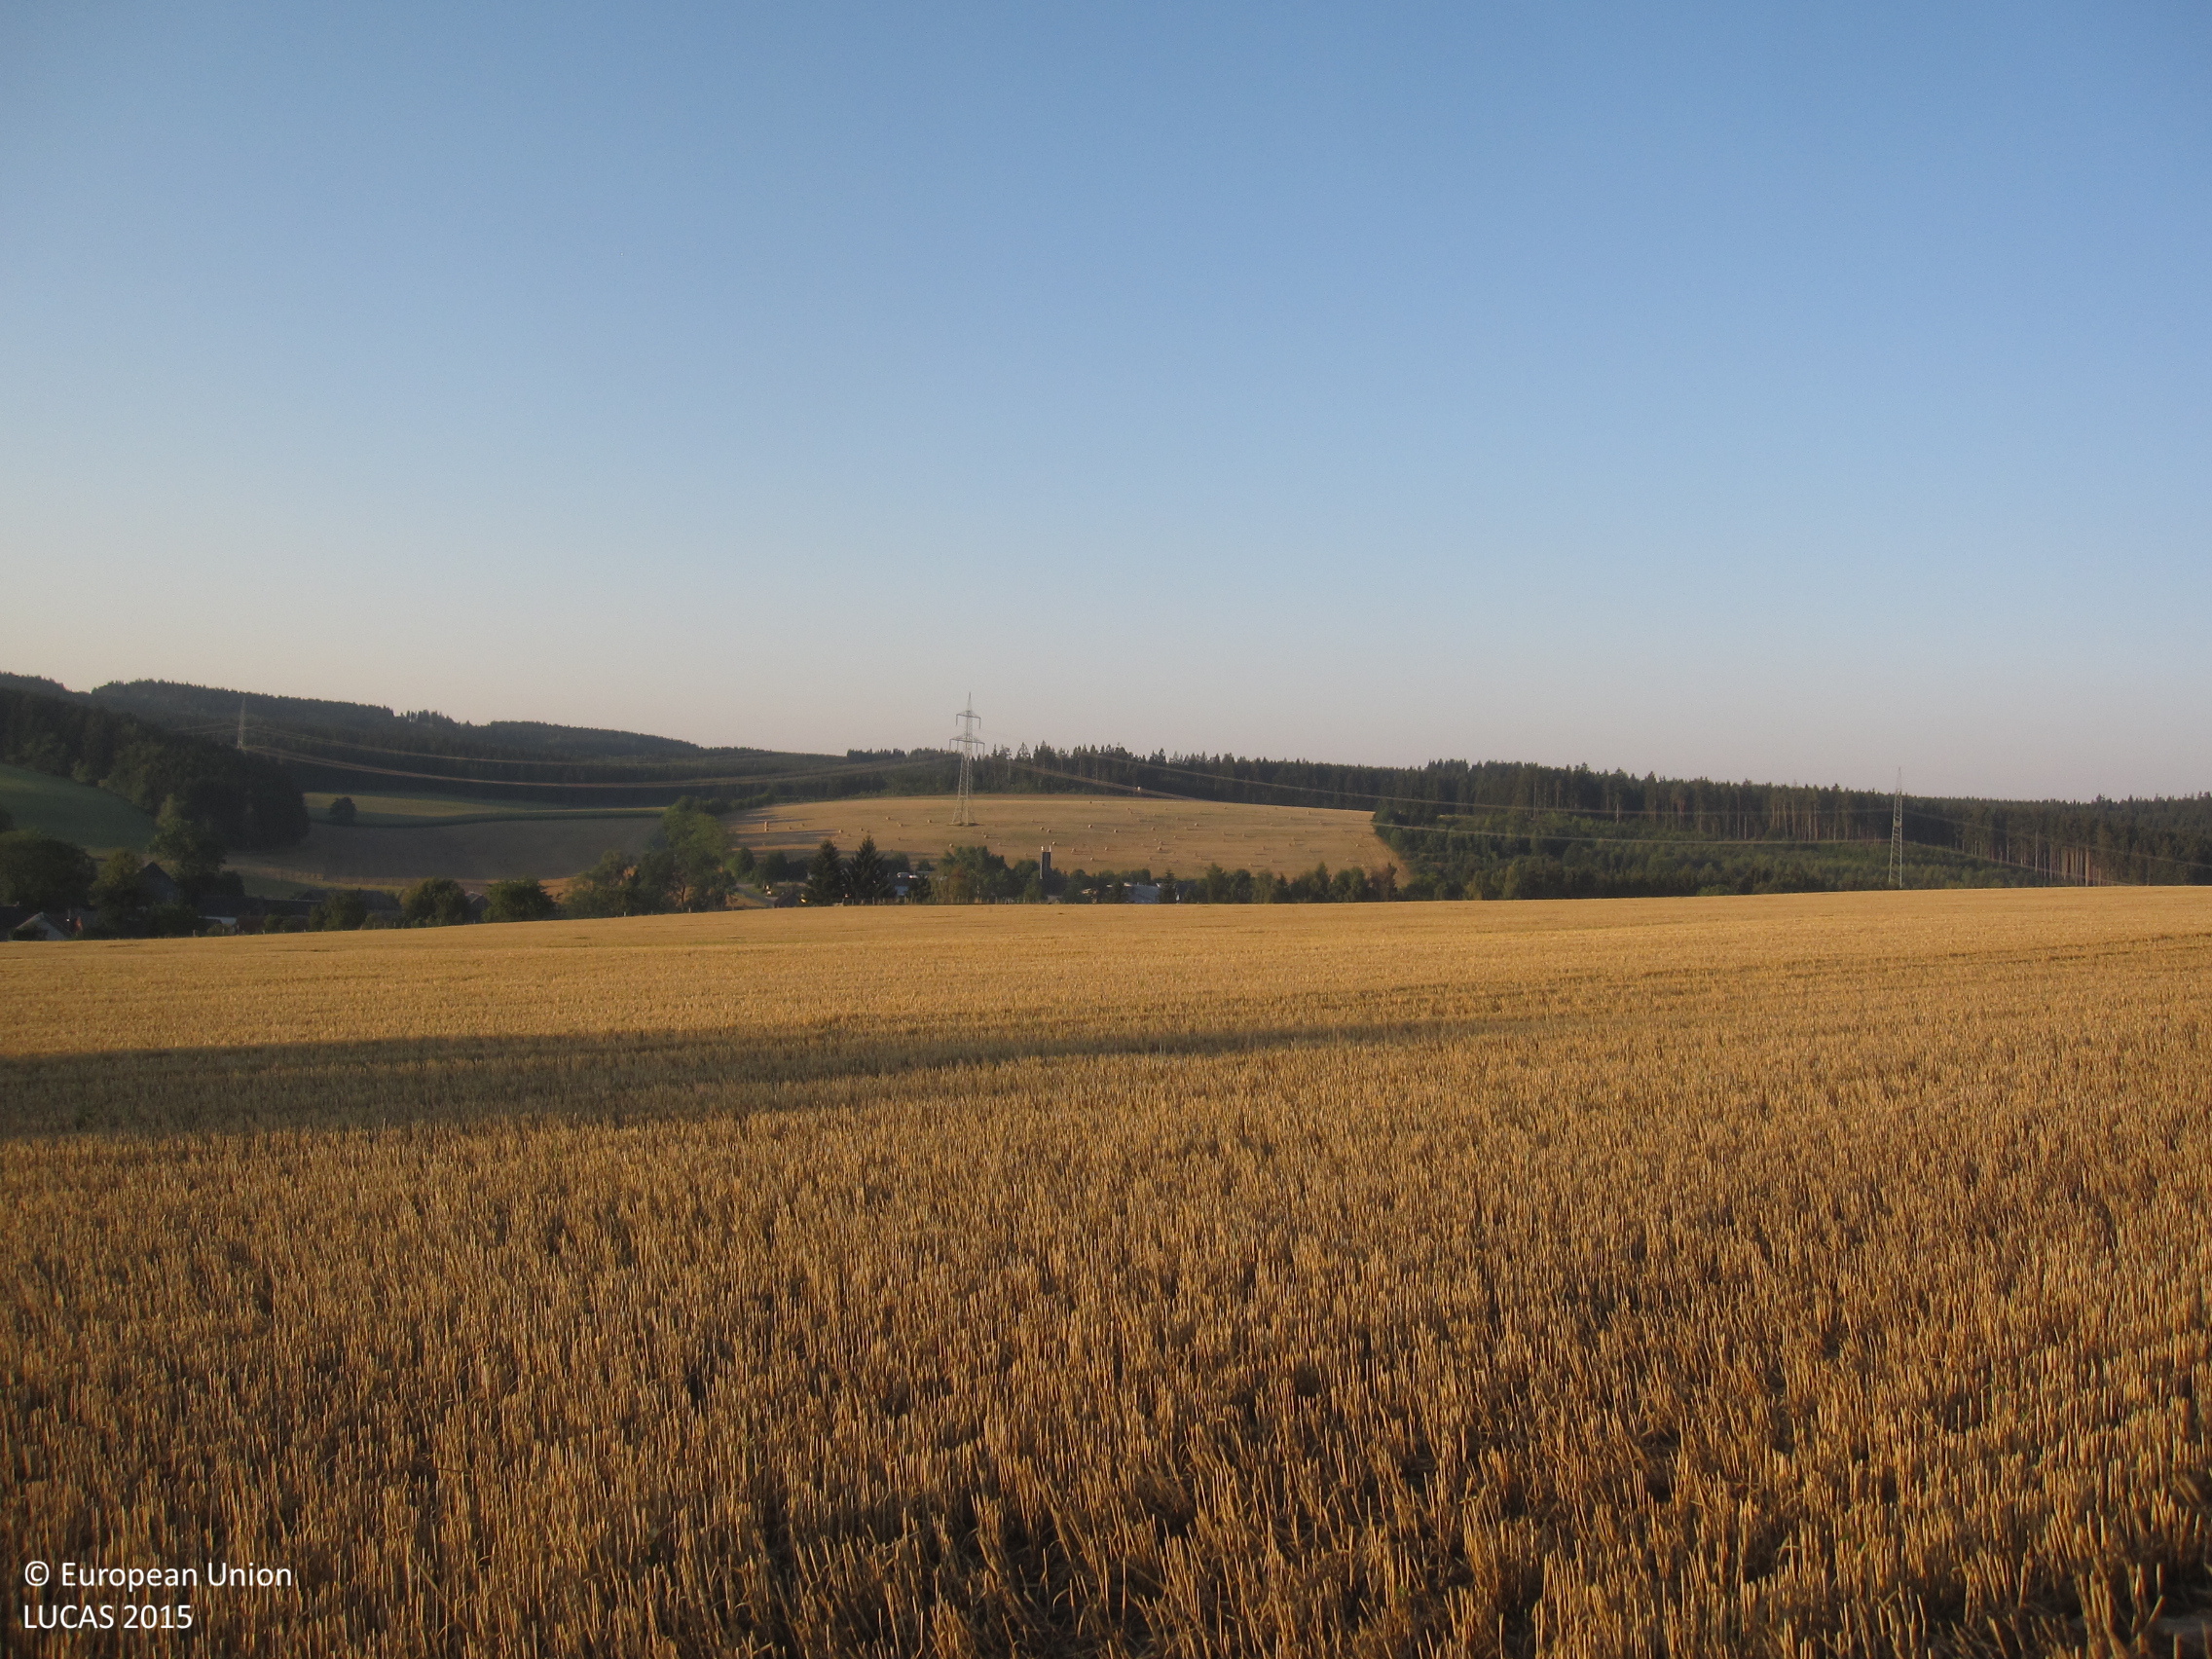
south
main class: Cropland
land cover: Barley
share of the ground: 25 - 50 %
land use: Agriculture (excluding fallow land and kitchen gardens)
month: August
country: DE
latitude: 50.5515
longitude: 11.5380
